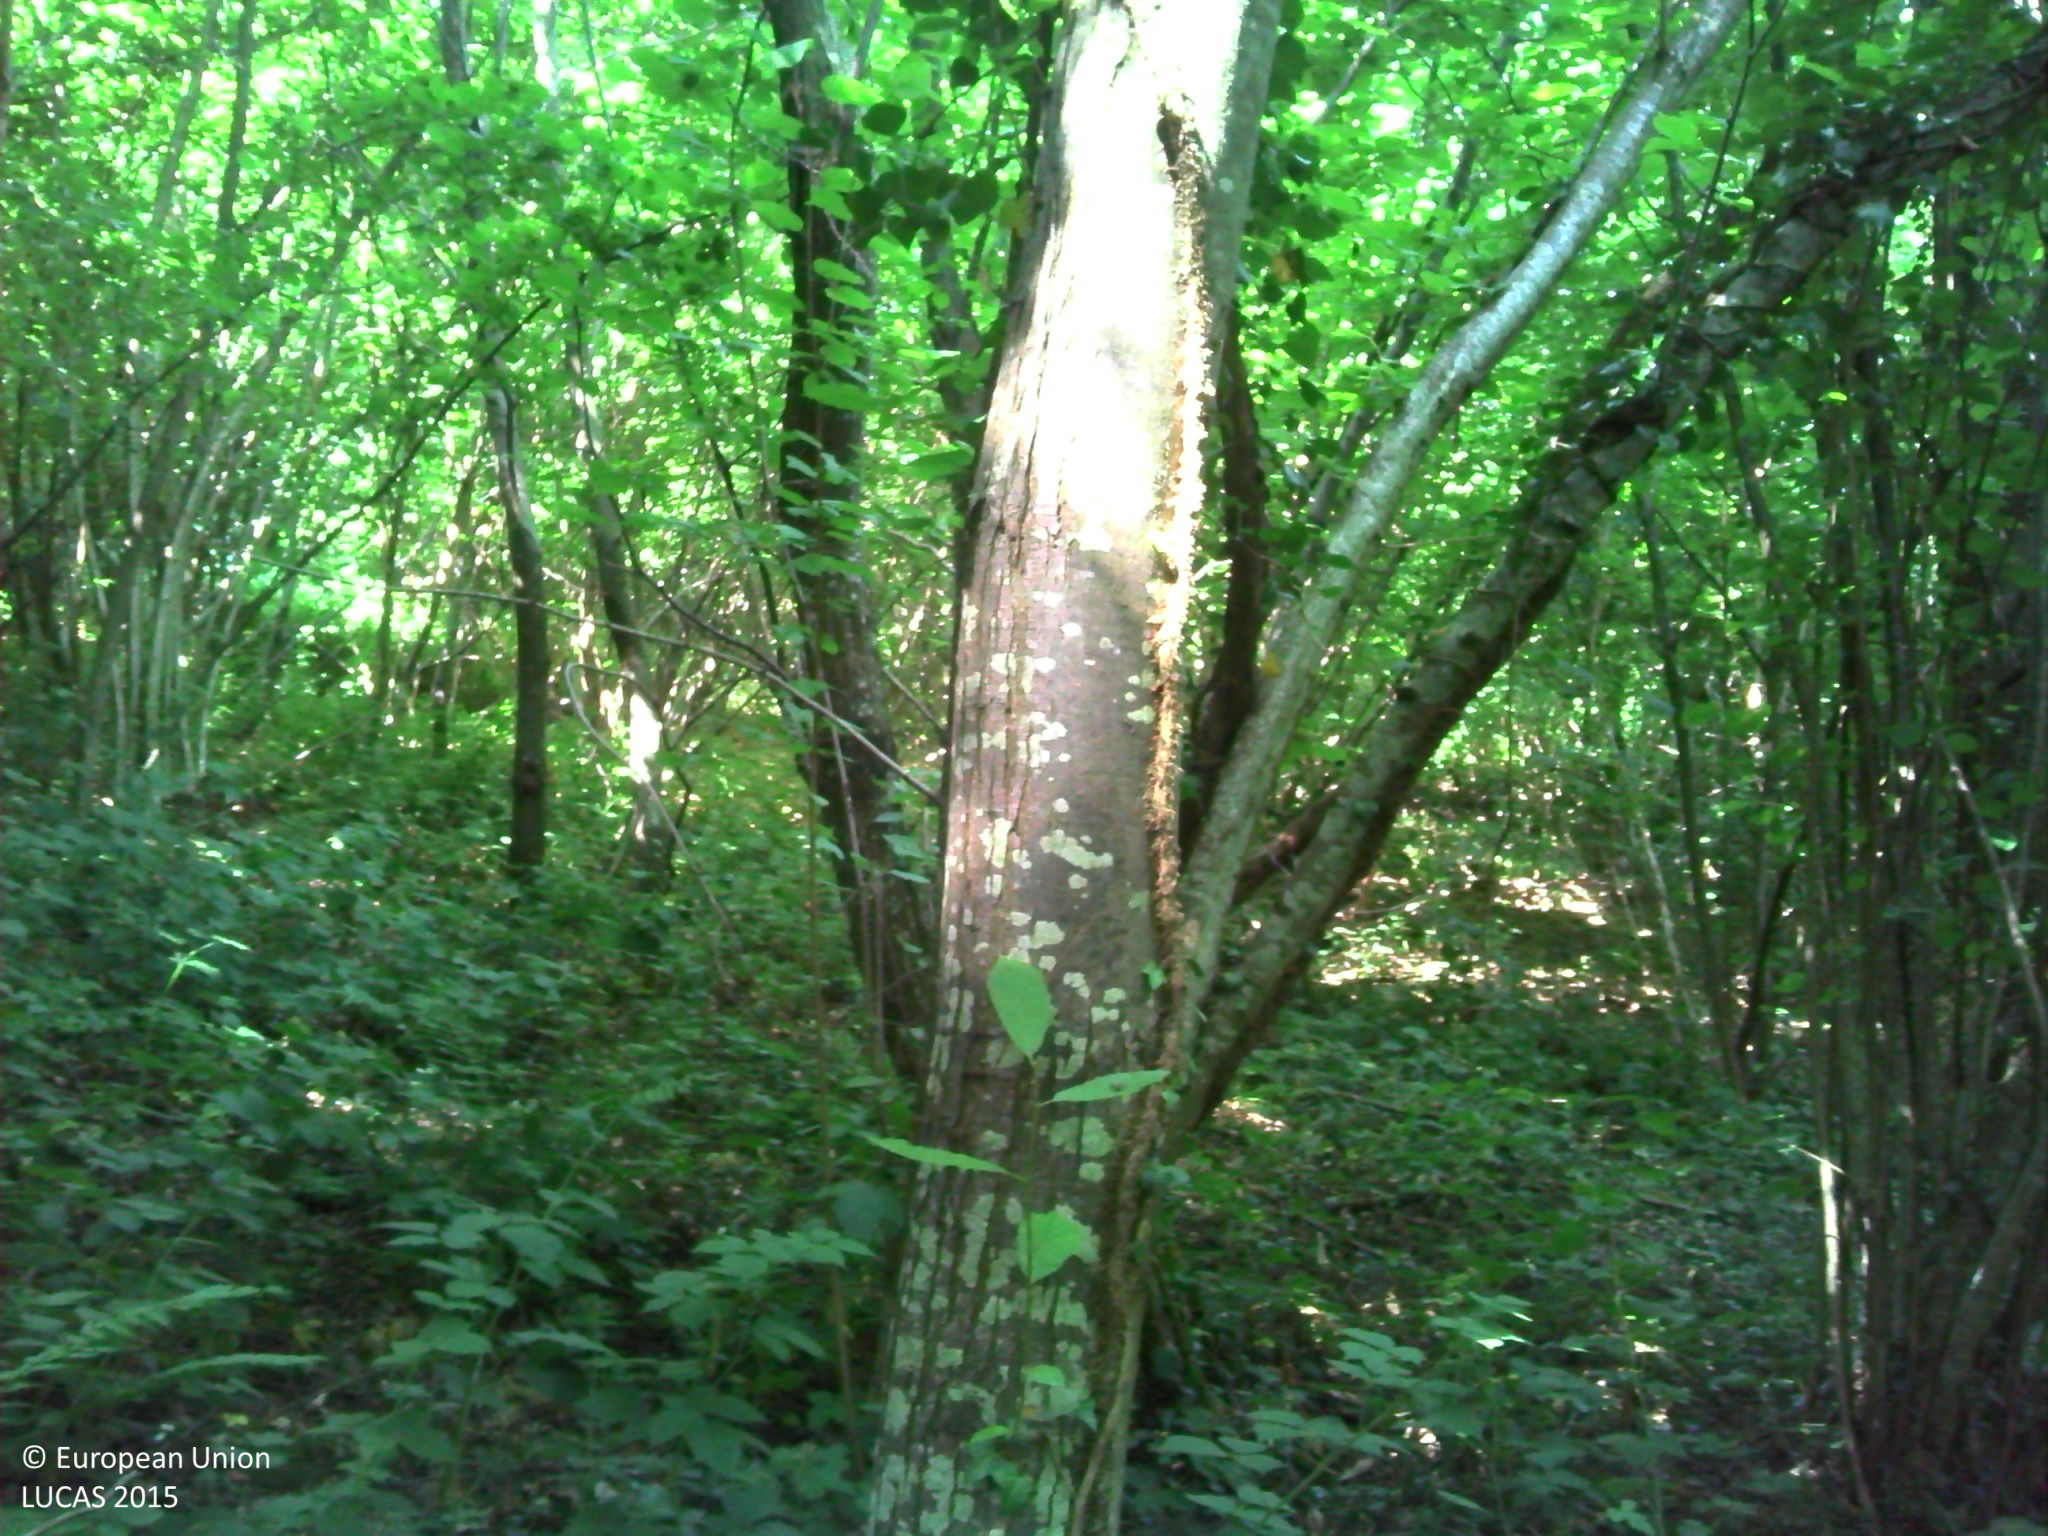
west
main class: Woodland
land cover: Broadleaved woodland
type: thermophilous deciduous forest
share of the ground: > 75 %
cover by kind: broadleaved forest trees 65 %, herbaceous plants 30 %, lichens and mosses 5 %
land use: Forestry
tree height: > 5 m
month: July
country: FR
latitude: 45.4993
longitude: 5.5127
